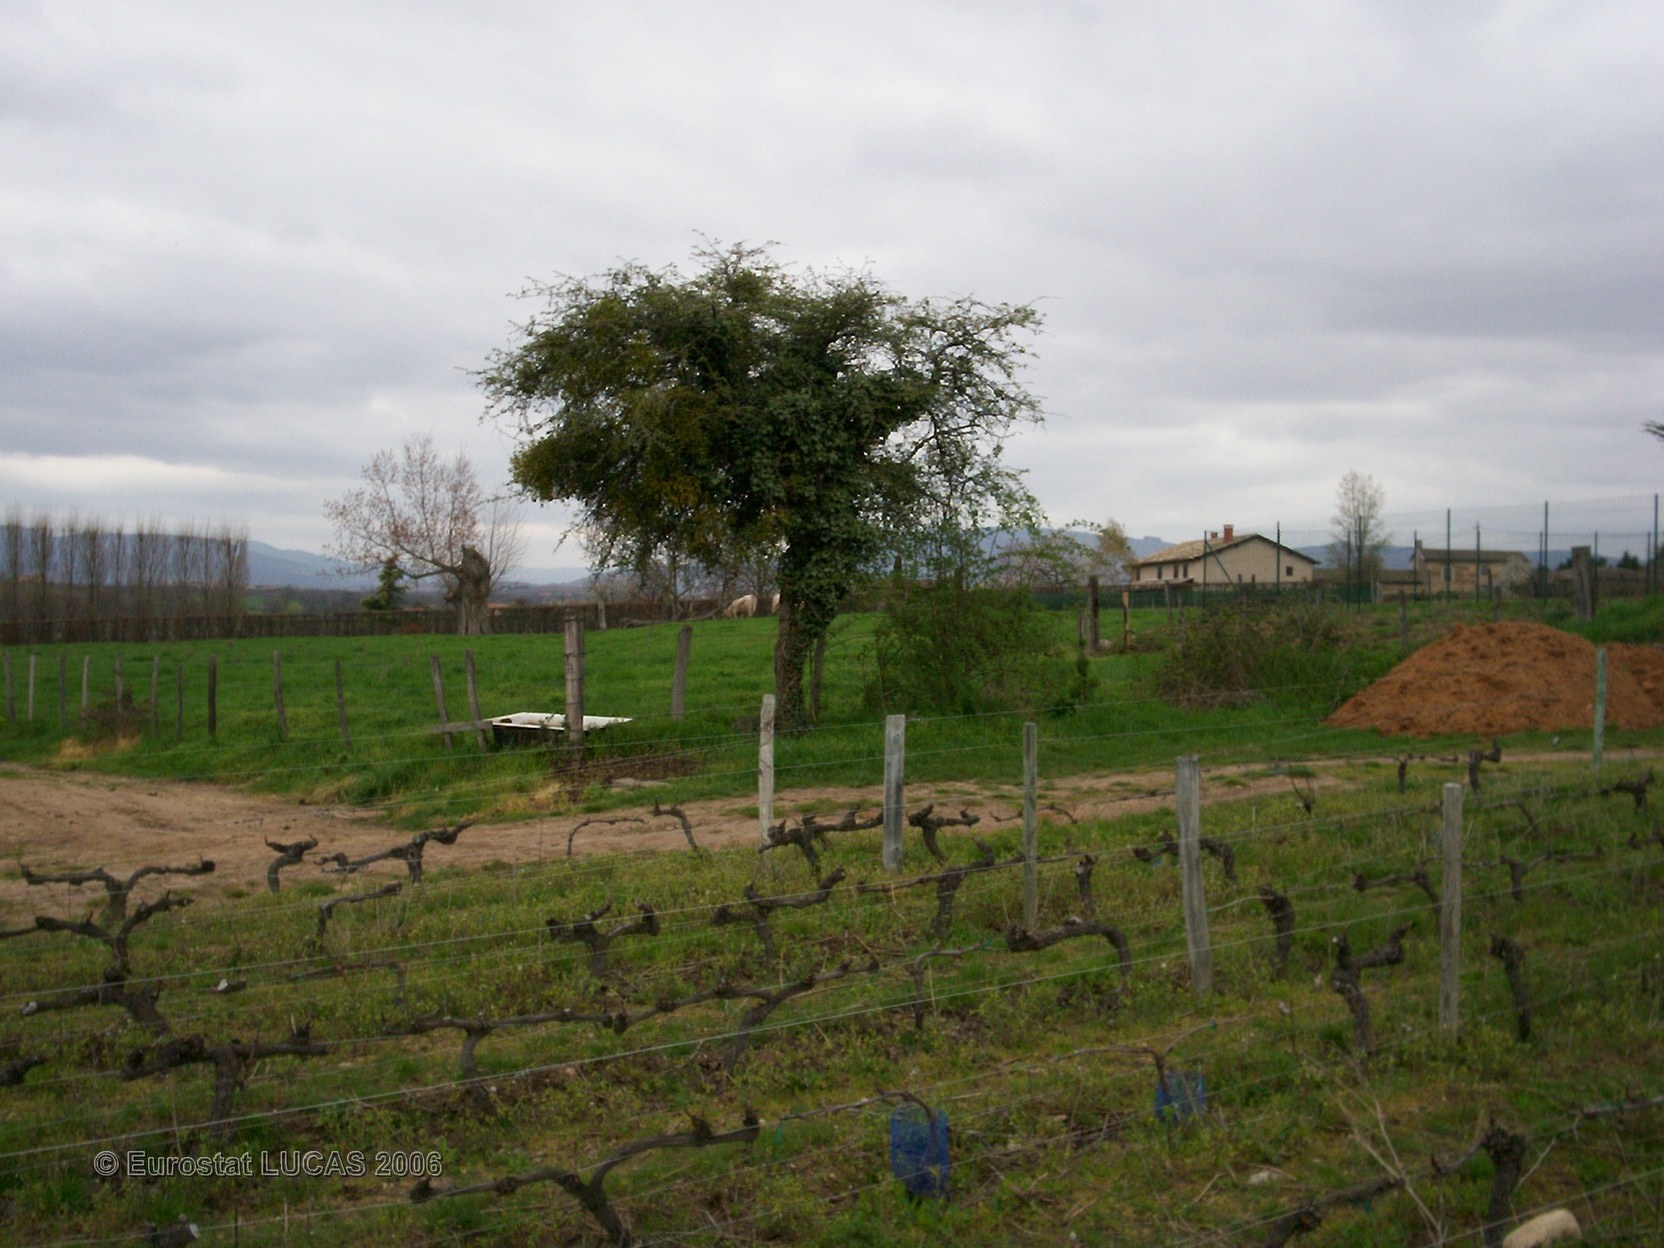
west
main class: Cropland
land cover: Vineyards
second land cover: Grassland without tree/shrub cover
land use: Agriculture (excluding fallow land and kitchen gardens)
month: April
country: FR
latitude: 46.1300
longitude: 4.7089
